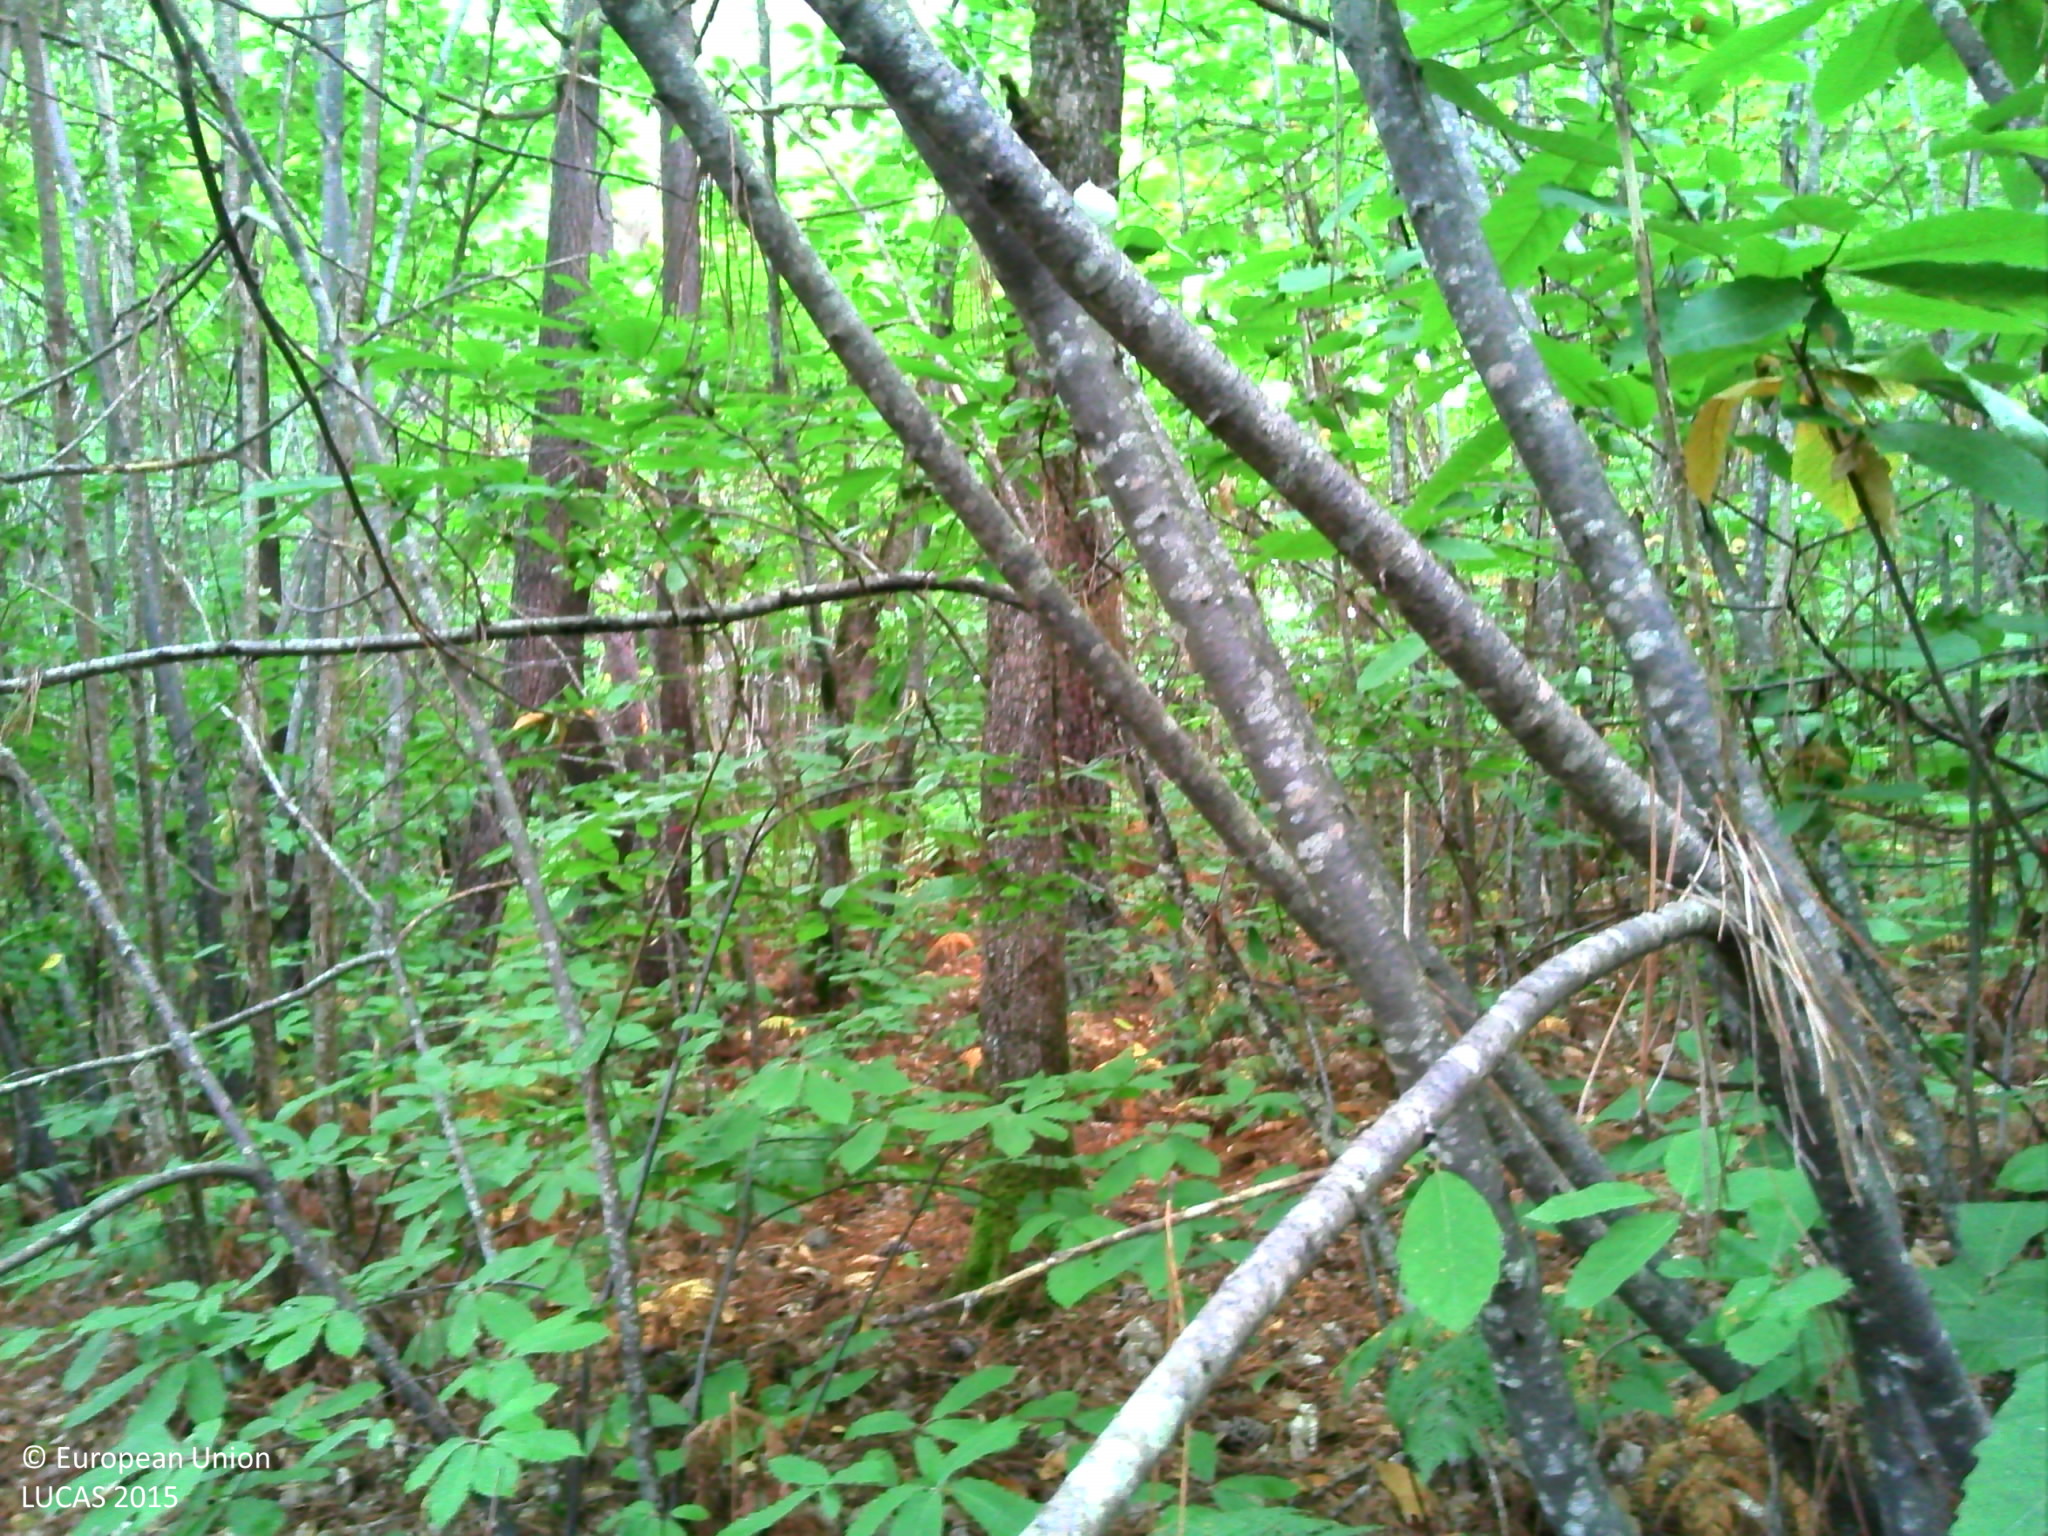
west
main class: Woodland
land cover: Pine dominated mixed woodland
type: thermophilous deciduous forest
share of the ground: > 75 %
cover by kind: broadleaved forest trees 55 %, coniferous forest trees 20 %, herbaceous plants 10 %, lichens and mosses 10 %, shrubs 5 %
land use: Forestry
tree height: > 5 m
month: July
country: FR
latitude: 44.9859
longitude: 0.9243
